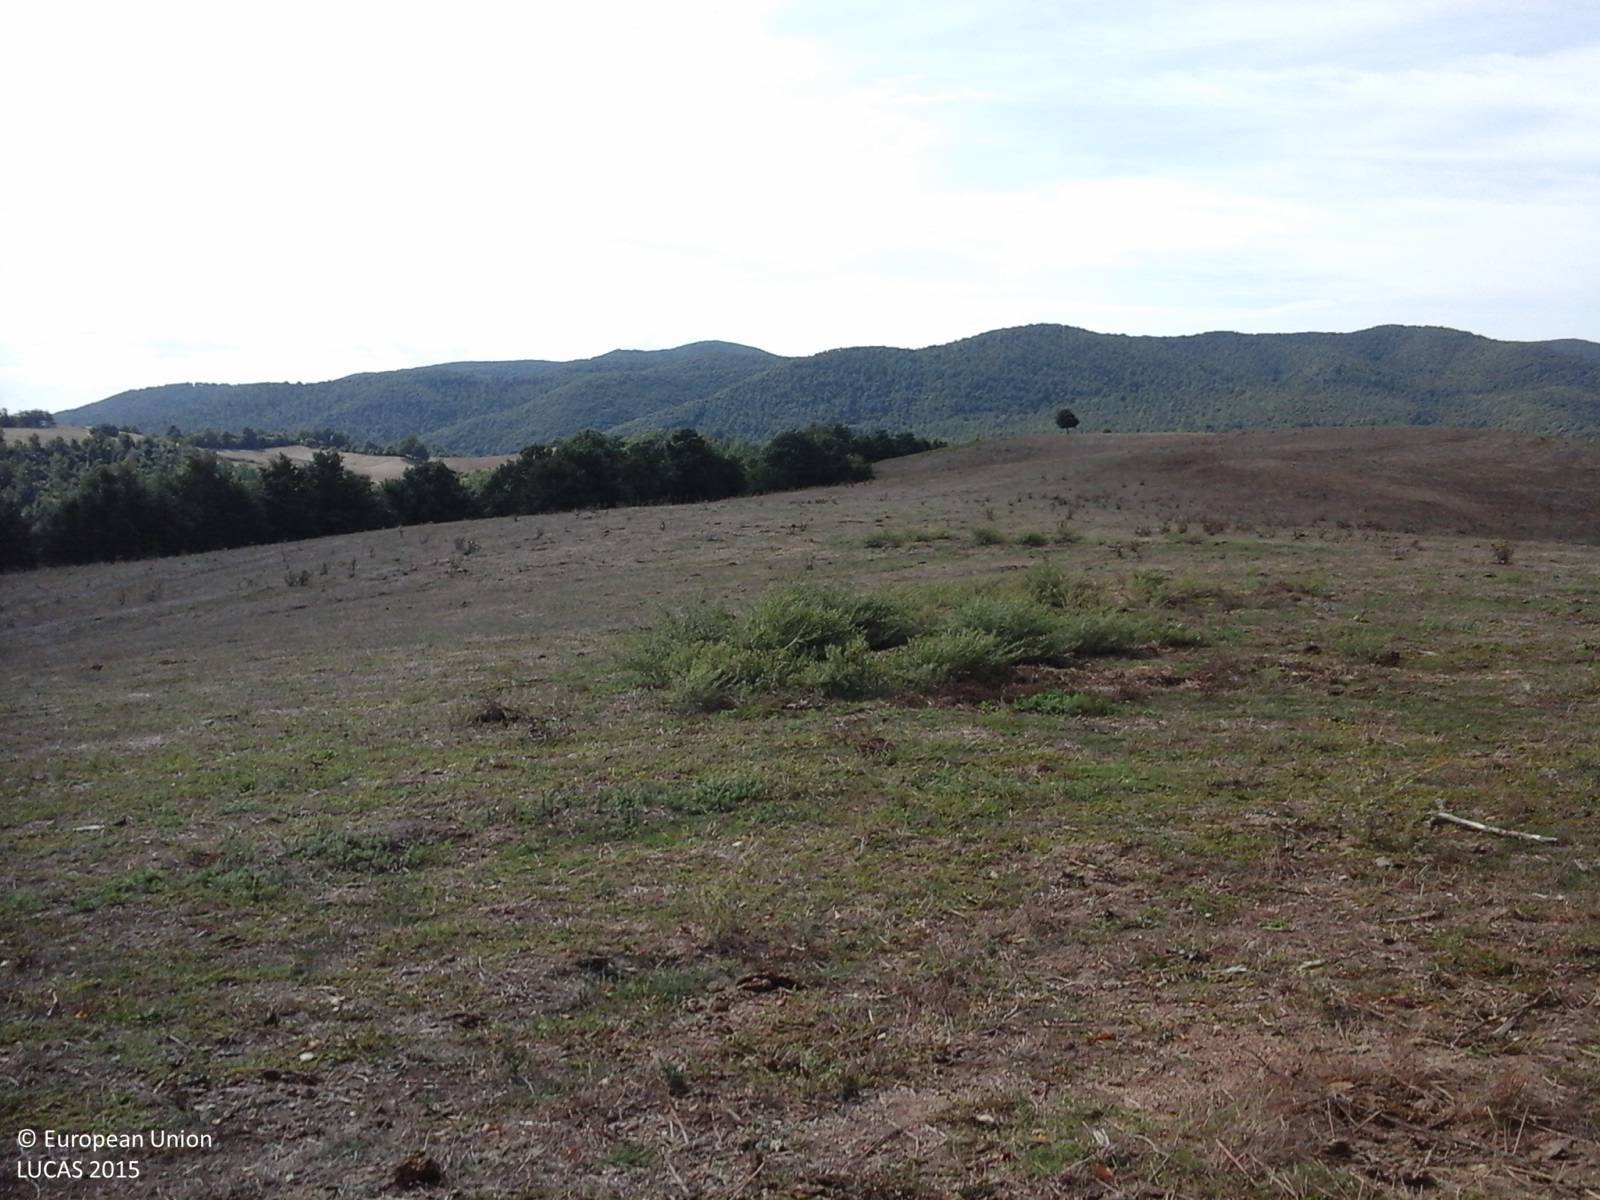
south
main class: Grassland
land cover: Grassland without tree/shrub cover
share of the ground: > 75 %
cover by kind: herbaceous plants 100 %
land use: Agriculture (excluding fallow land and kitchen gardens)
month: September
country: IT
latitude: 42.5512
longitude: 11.5900
